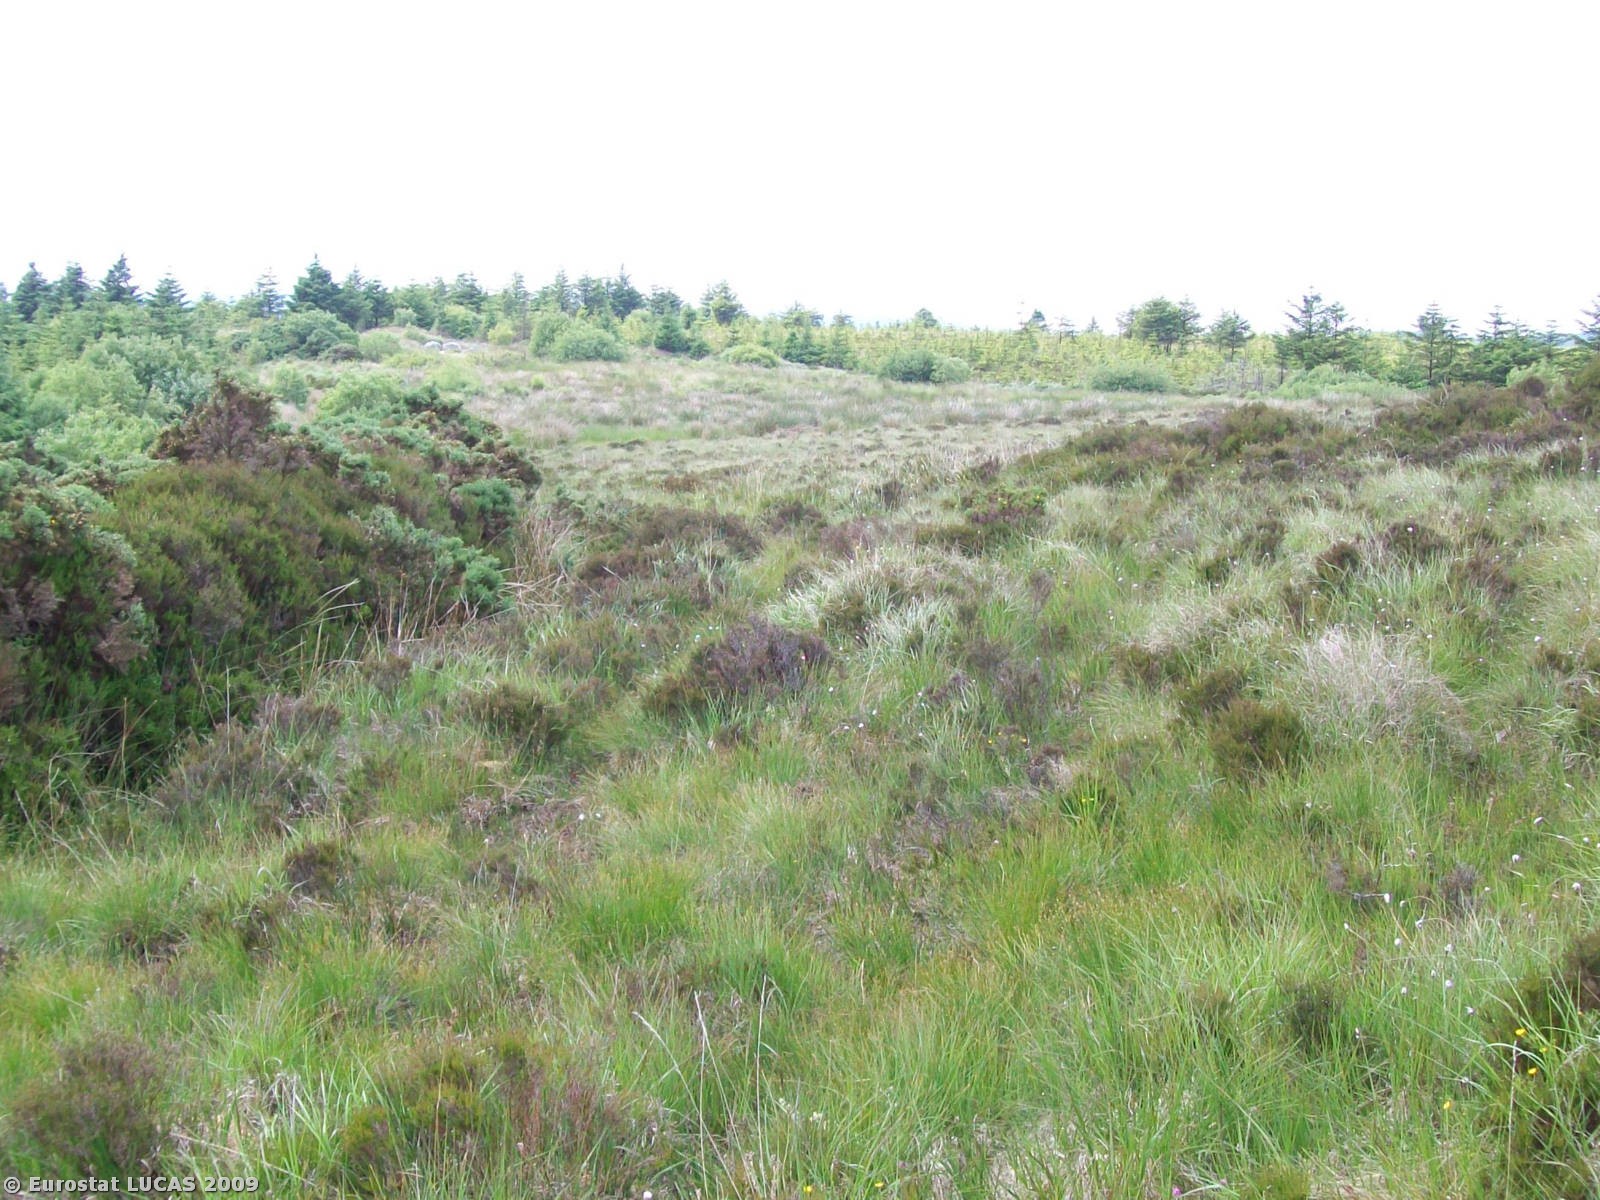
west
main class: Shrubland
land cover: Shrubland without tree cover
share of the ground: > 75 %
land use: Agriculture (excluding fallow land and kitchen gardens)
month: June
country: GB
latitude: 54.2874
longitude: -7.2456
